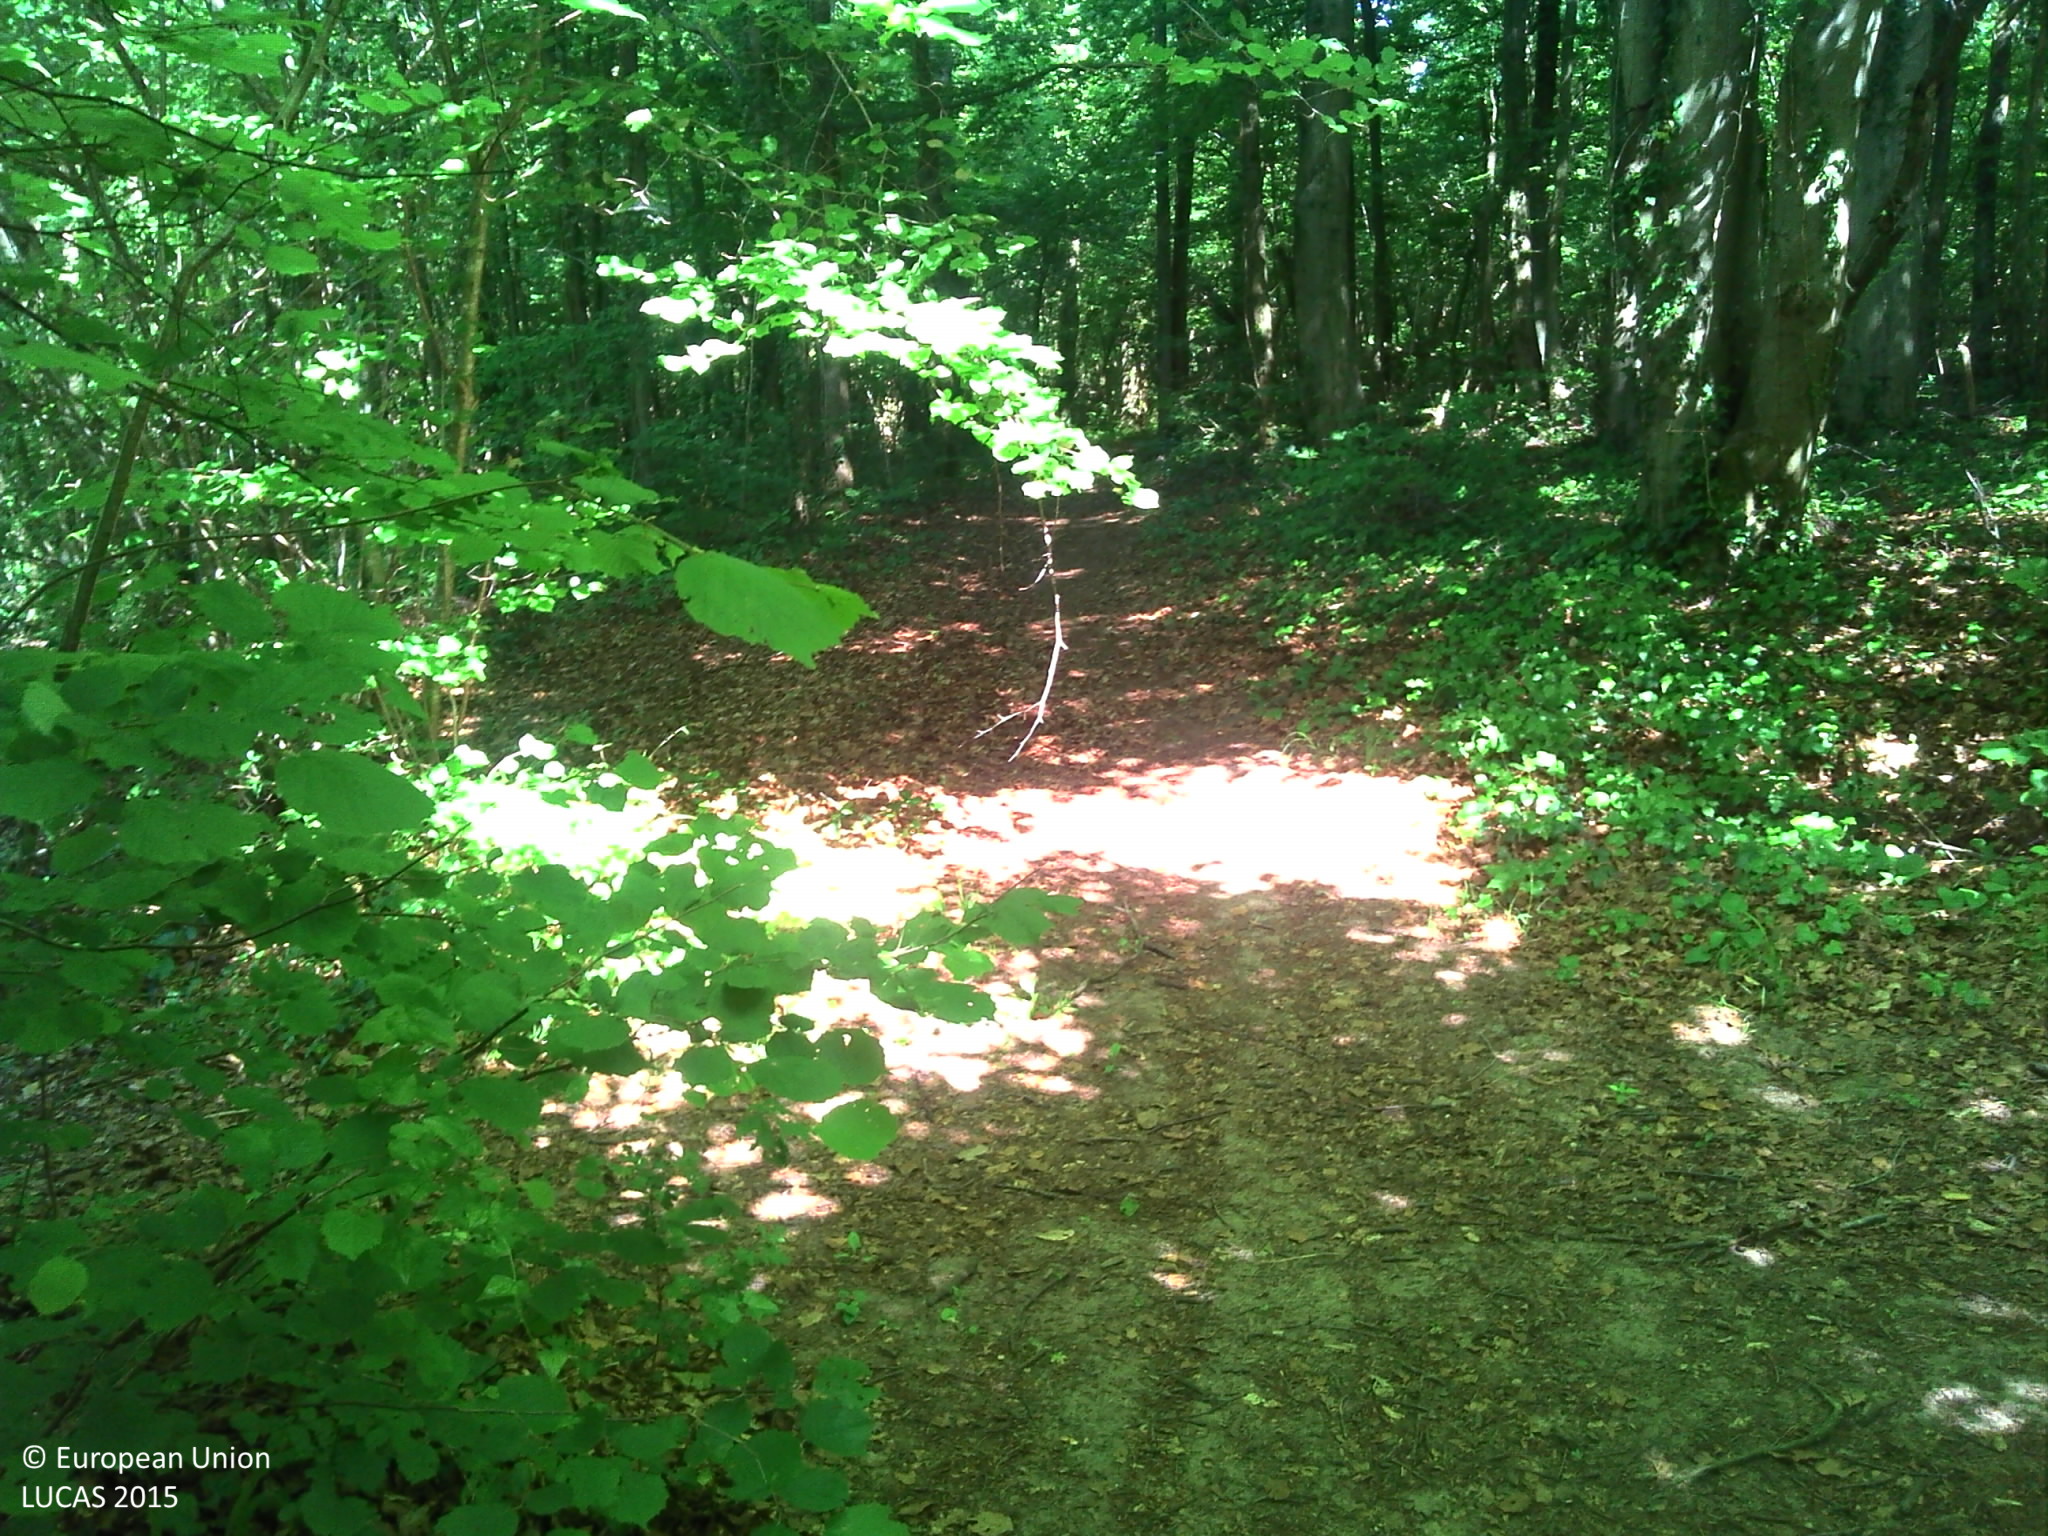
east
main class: Woodland
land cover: Broadleaved woodland
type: beech forest
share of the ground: > 75 %
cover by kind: broadleaved forest trees 90 %, coniferous forest trees 10 %
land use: Forestry
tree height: > 5 m
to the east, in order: Broadleaved woodland; Tracks; Broadleaved woodland; Tracks; Broadleaved woodland; Tracks; Broadleaved woodland
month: June
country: FR
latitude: 49.4085
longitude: 3.2800
